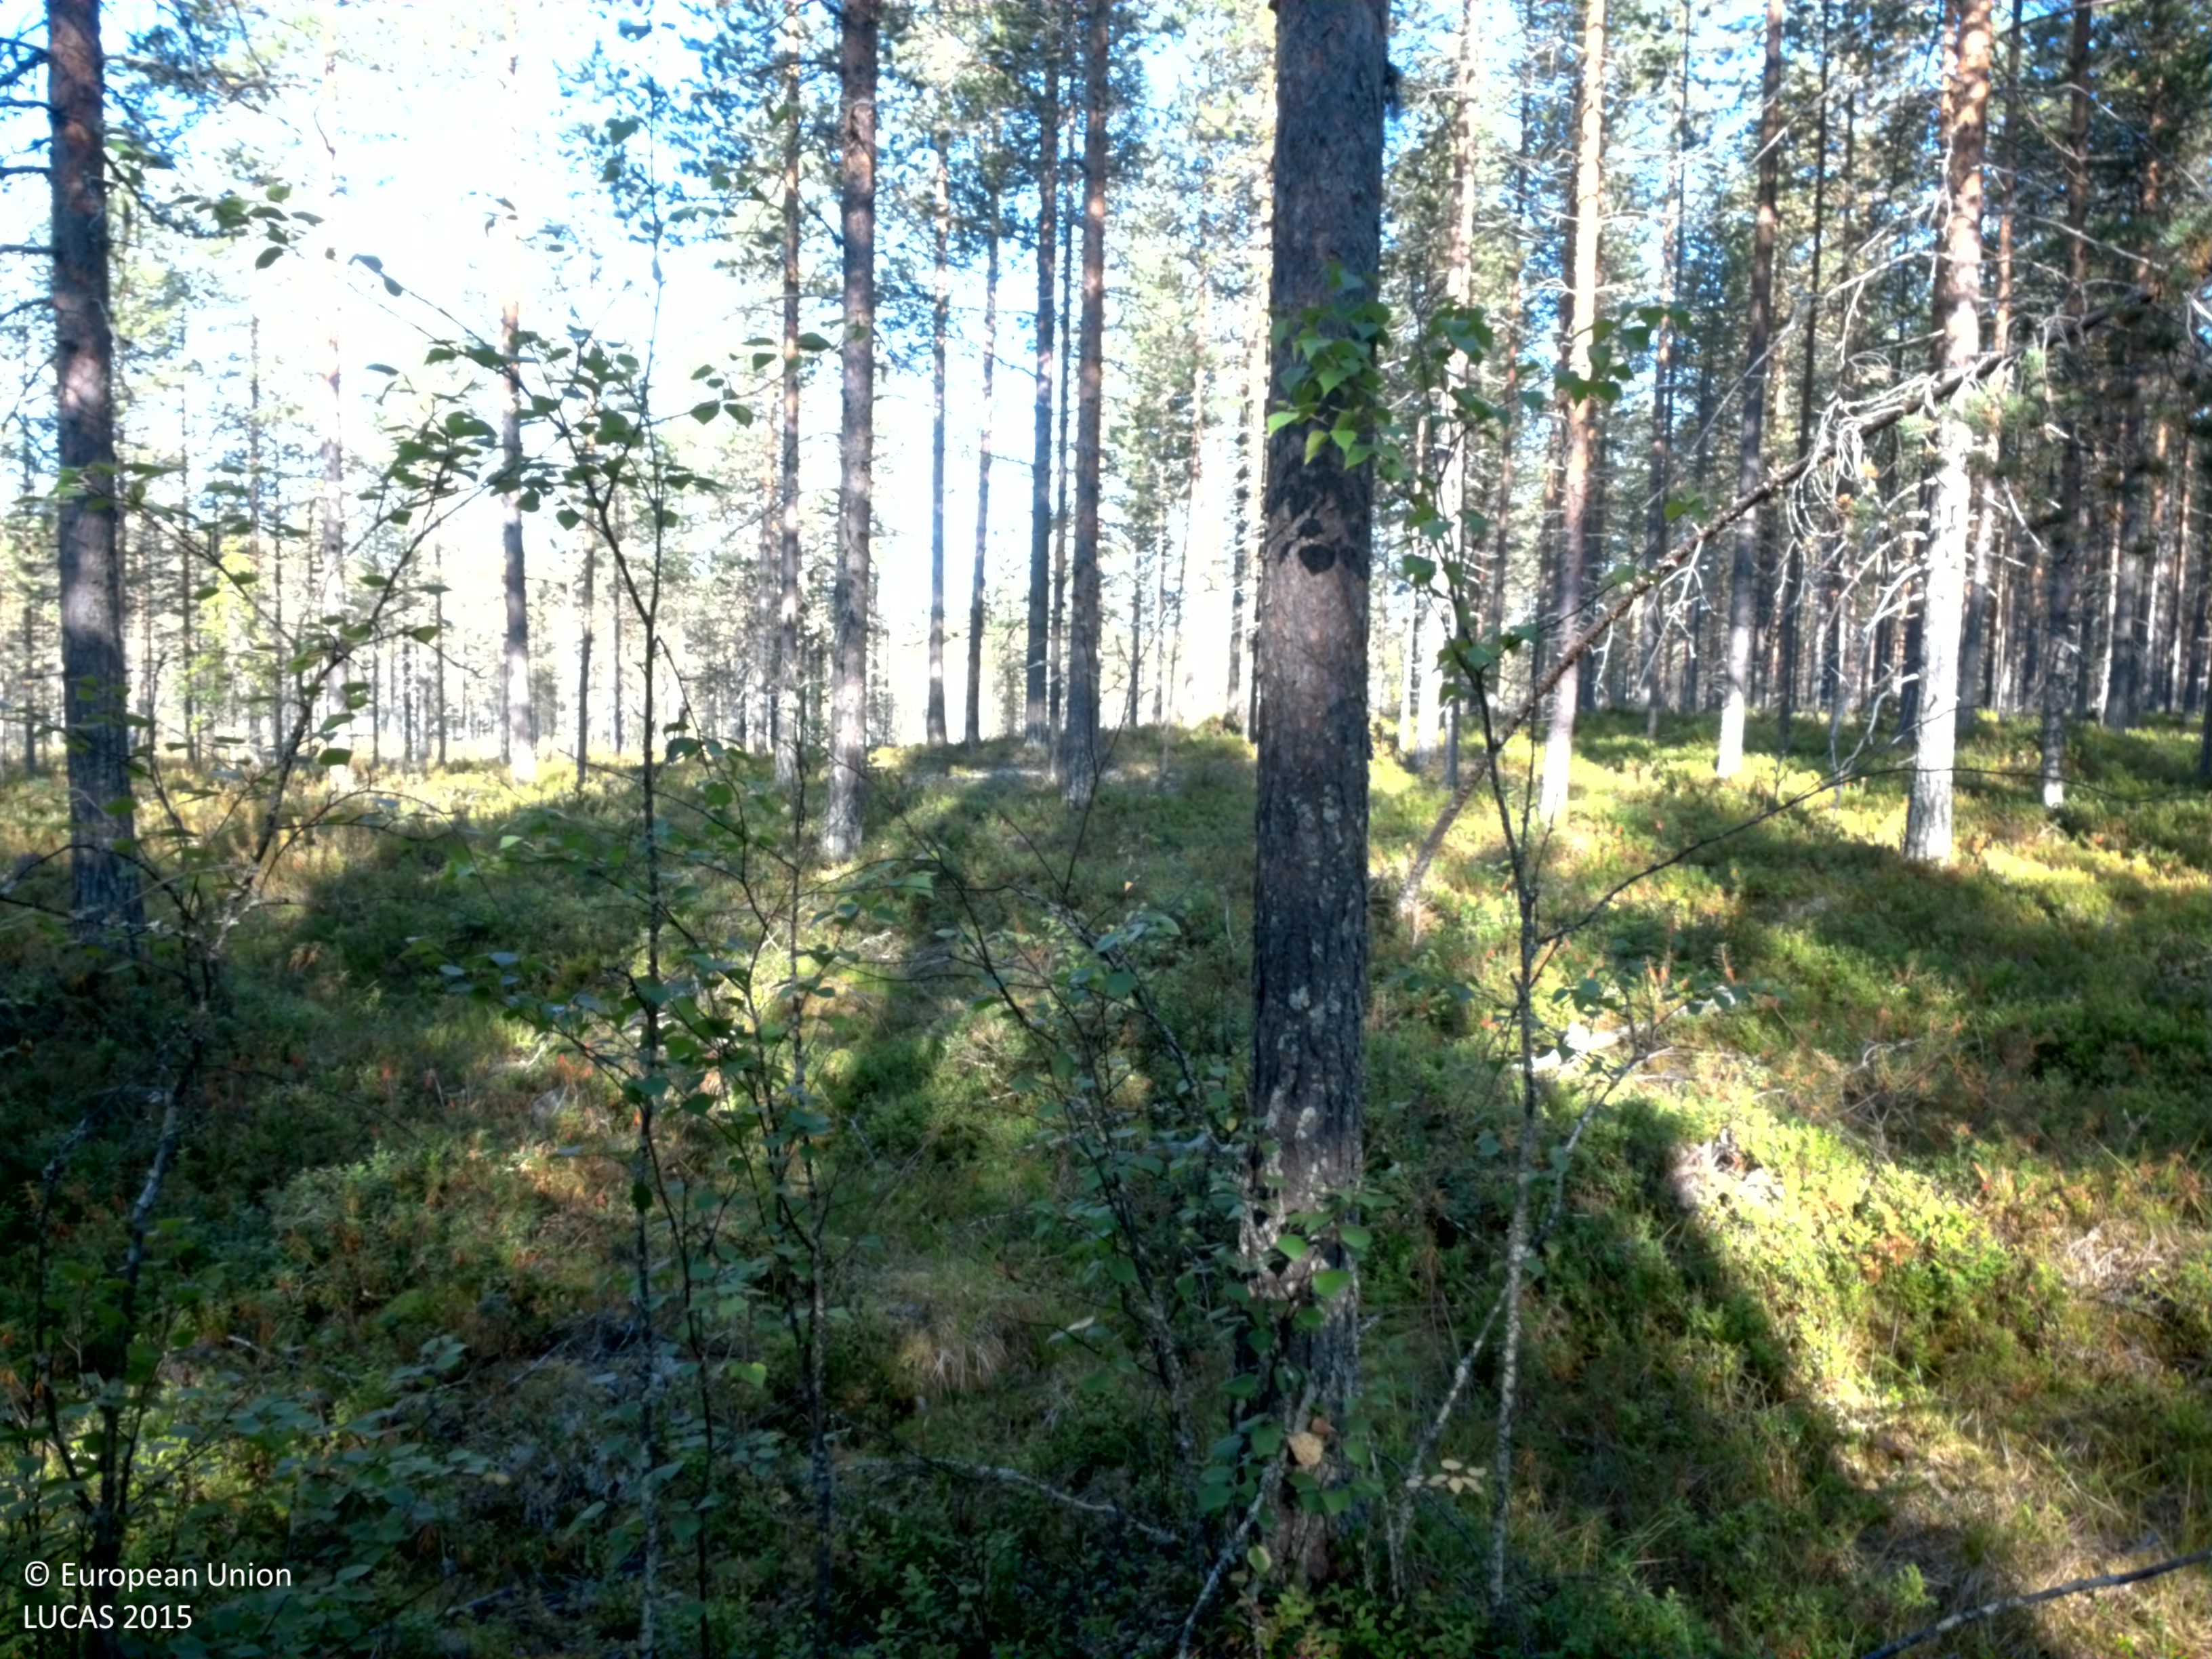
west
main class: Woodland
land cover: Pine dominated mixed woodland
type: boreal forest
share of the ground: 50 - 75 %
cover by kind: coniferous forest trees 45 %, shrubs 35 %, broadleaved forest trees 15 %, lichens and mosses 5 %
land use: Forestry
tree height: > 5 m
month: August
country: SE
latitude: 64.5542
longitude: 18.7923
